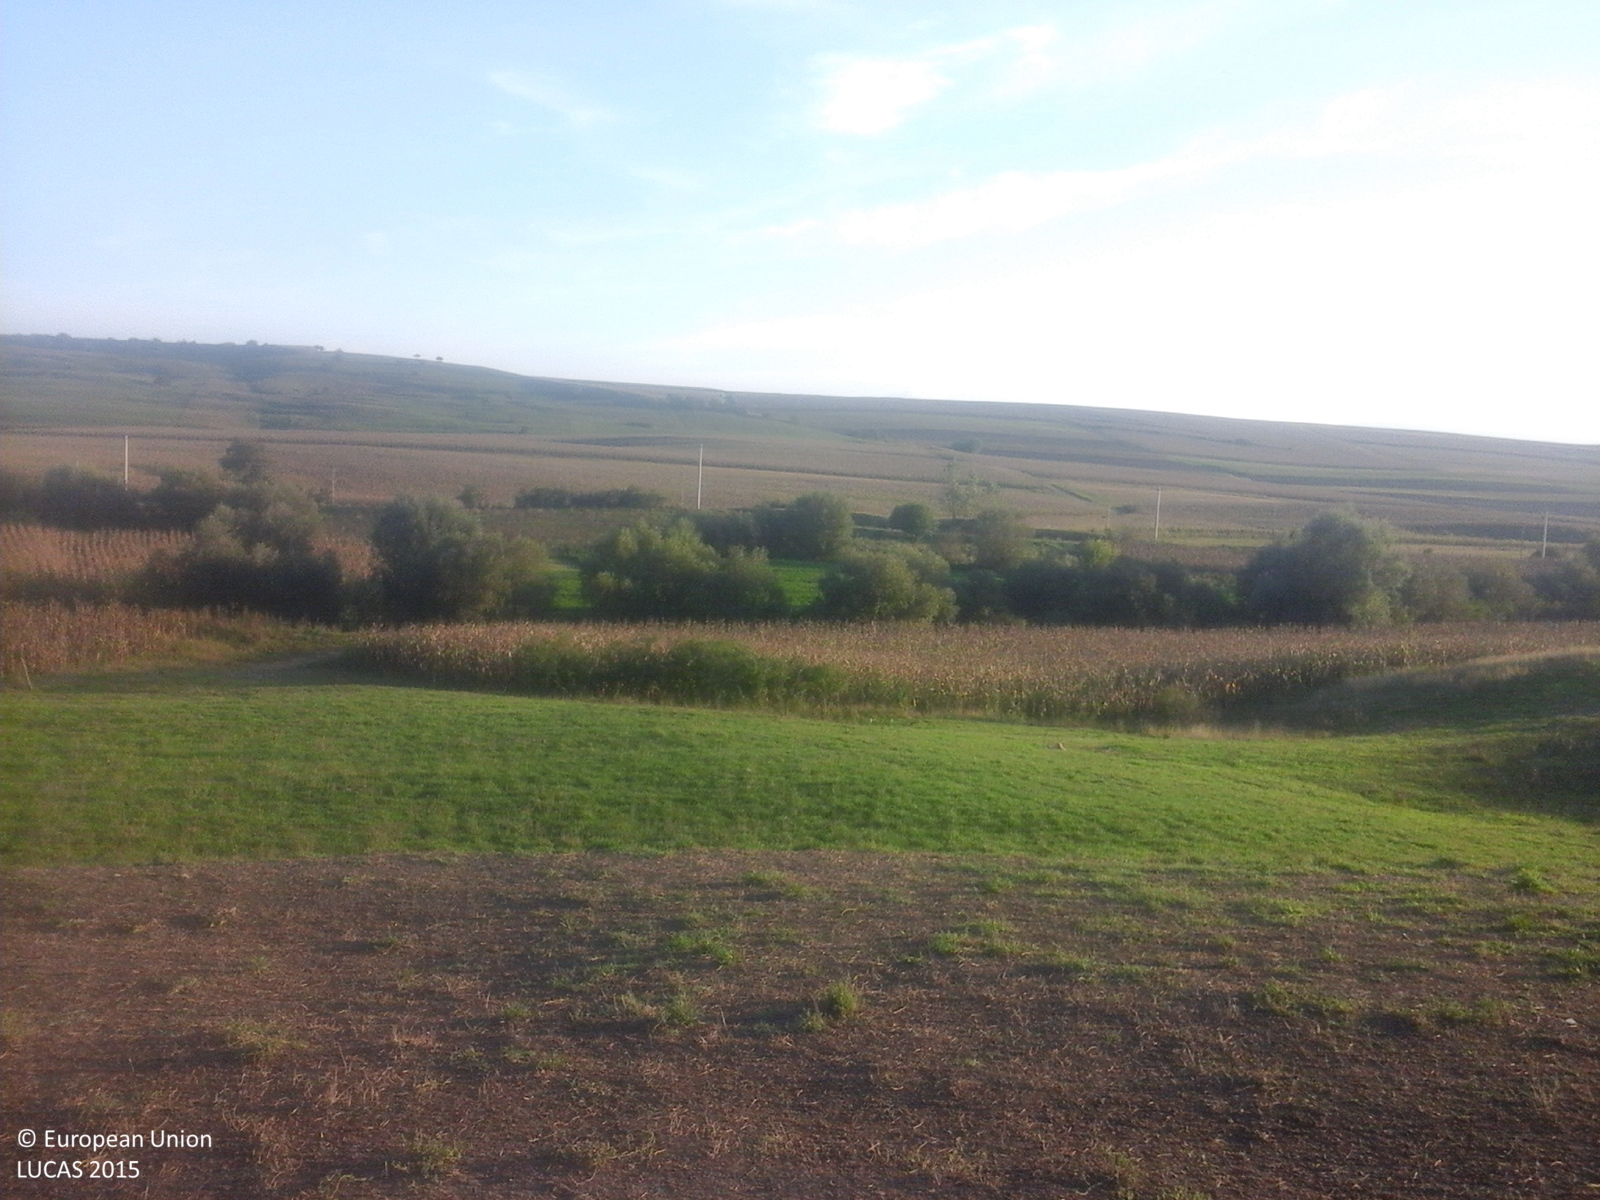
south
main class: Grassland
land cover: Grassland without tree/shrub cover
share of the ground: > 75 %
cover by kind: herbaceous plants 100 %
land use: Agriculture (excluding fallow land and kitchen gardens)
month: October
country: RO
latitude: 45.9243
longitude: 24.0914
